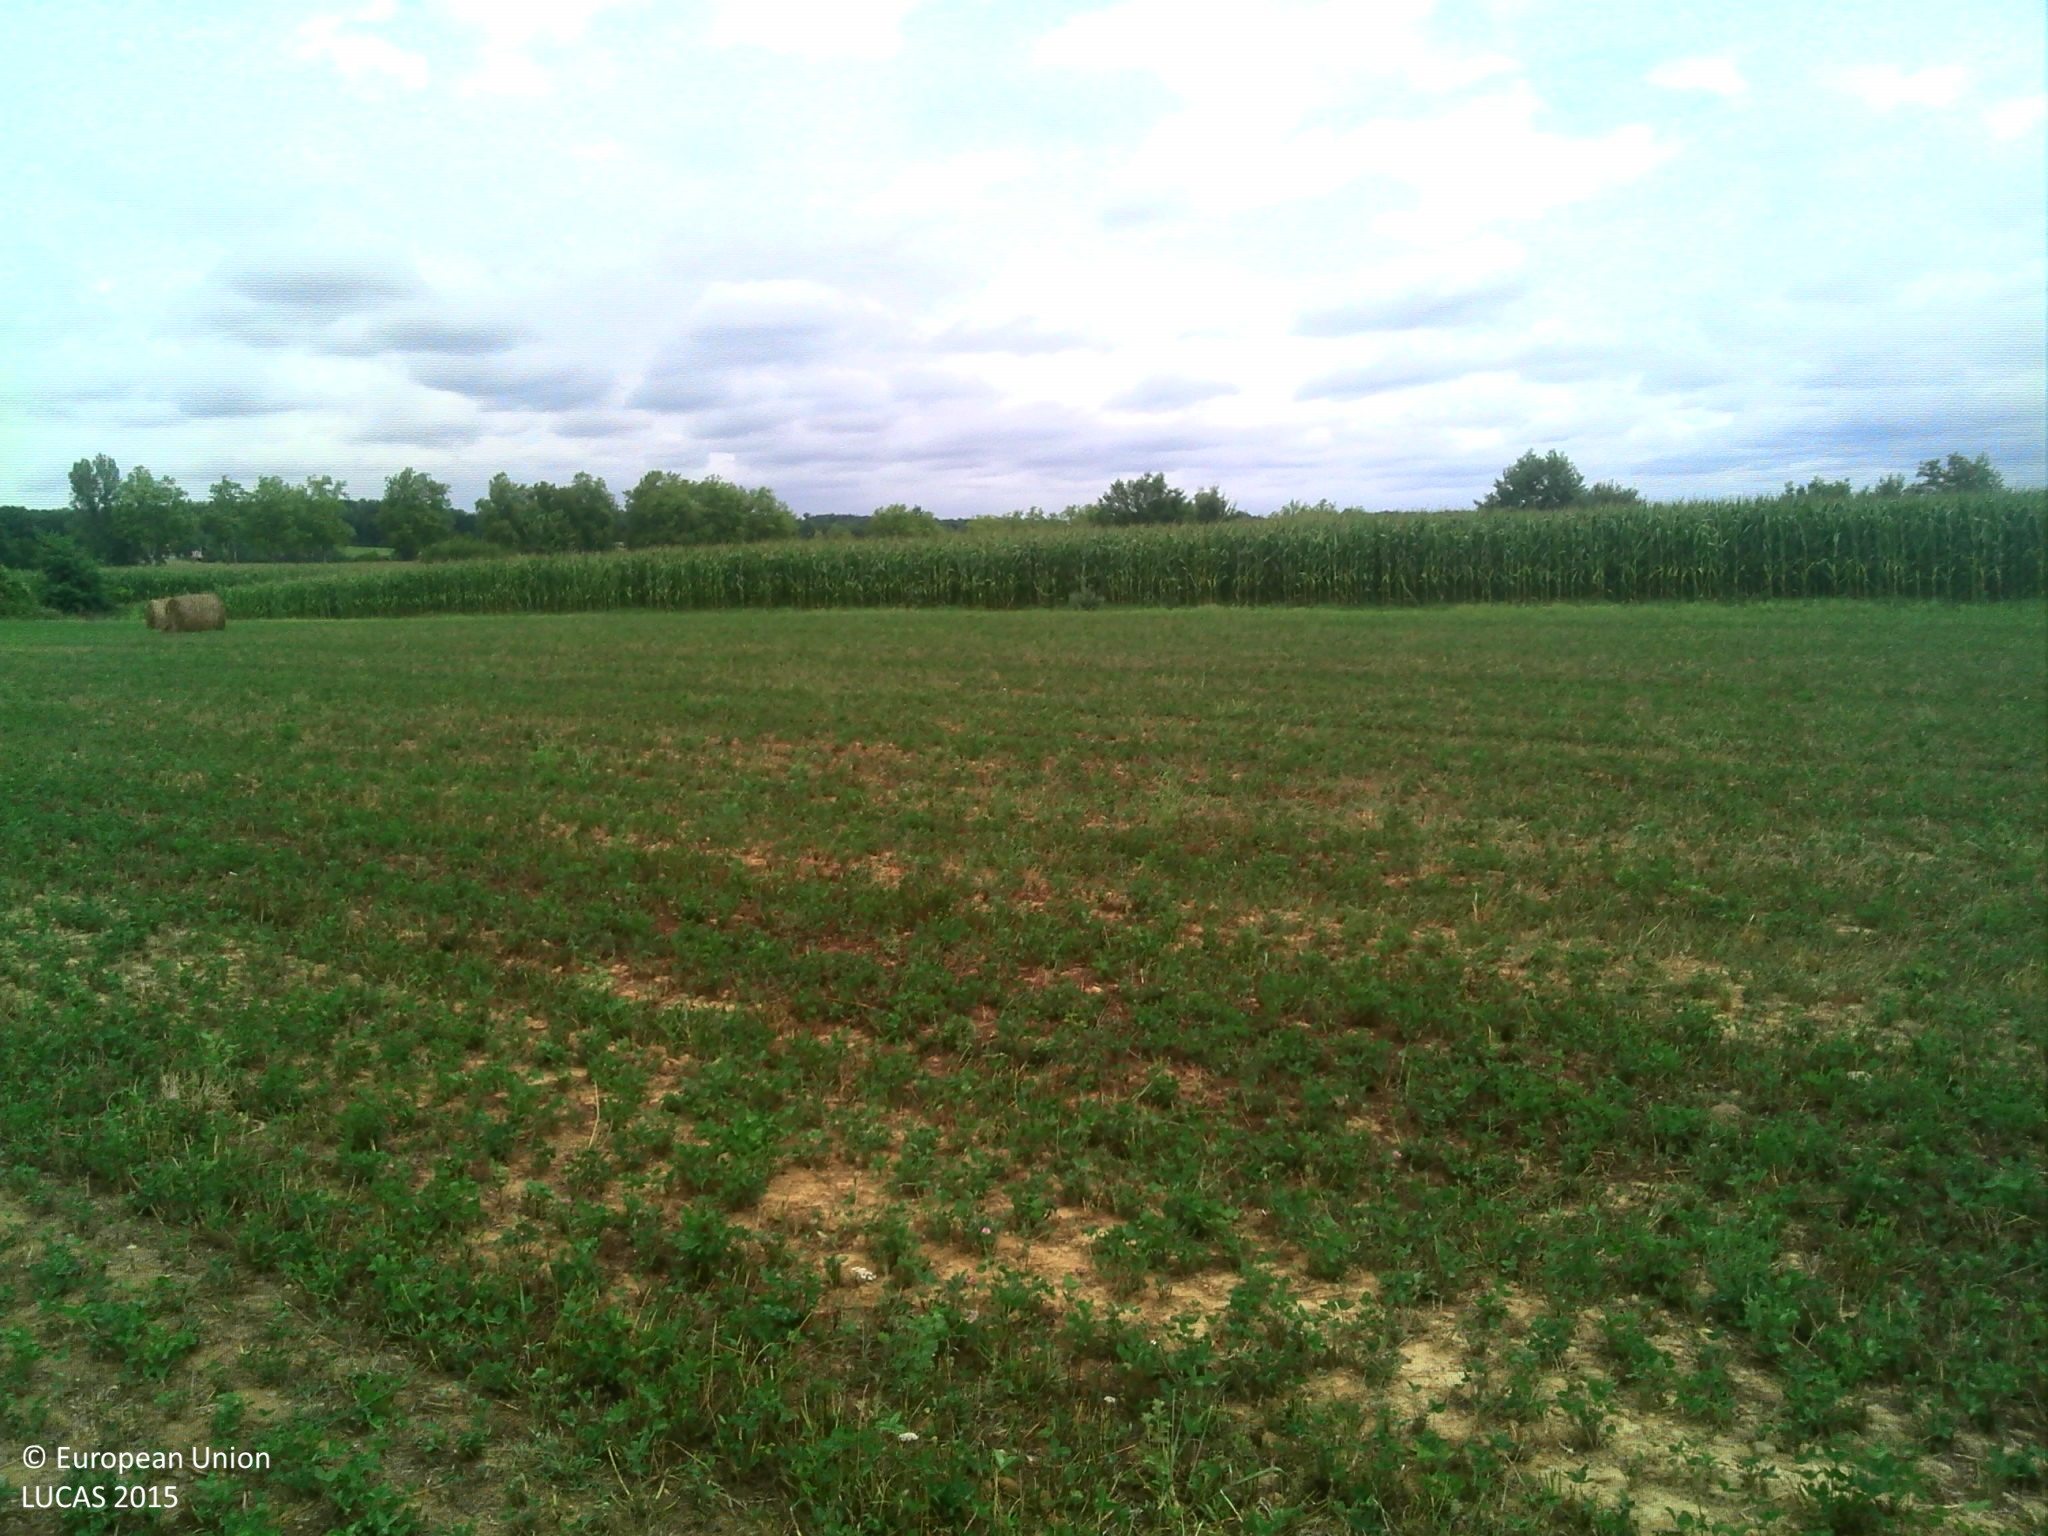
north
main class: Cropland
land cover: Temporary grasslands
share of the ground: > 75 %
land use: Agriculture (excluding fallow land and kitchen gardens)
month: July
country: FR
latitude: 43.3231
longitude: 0.7892
